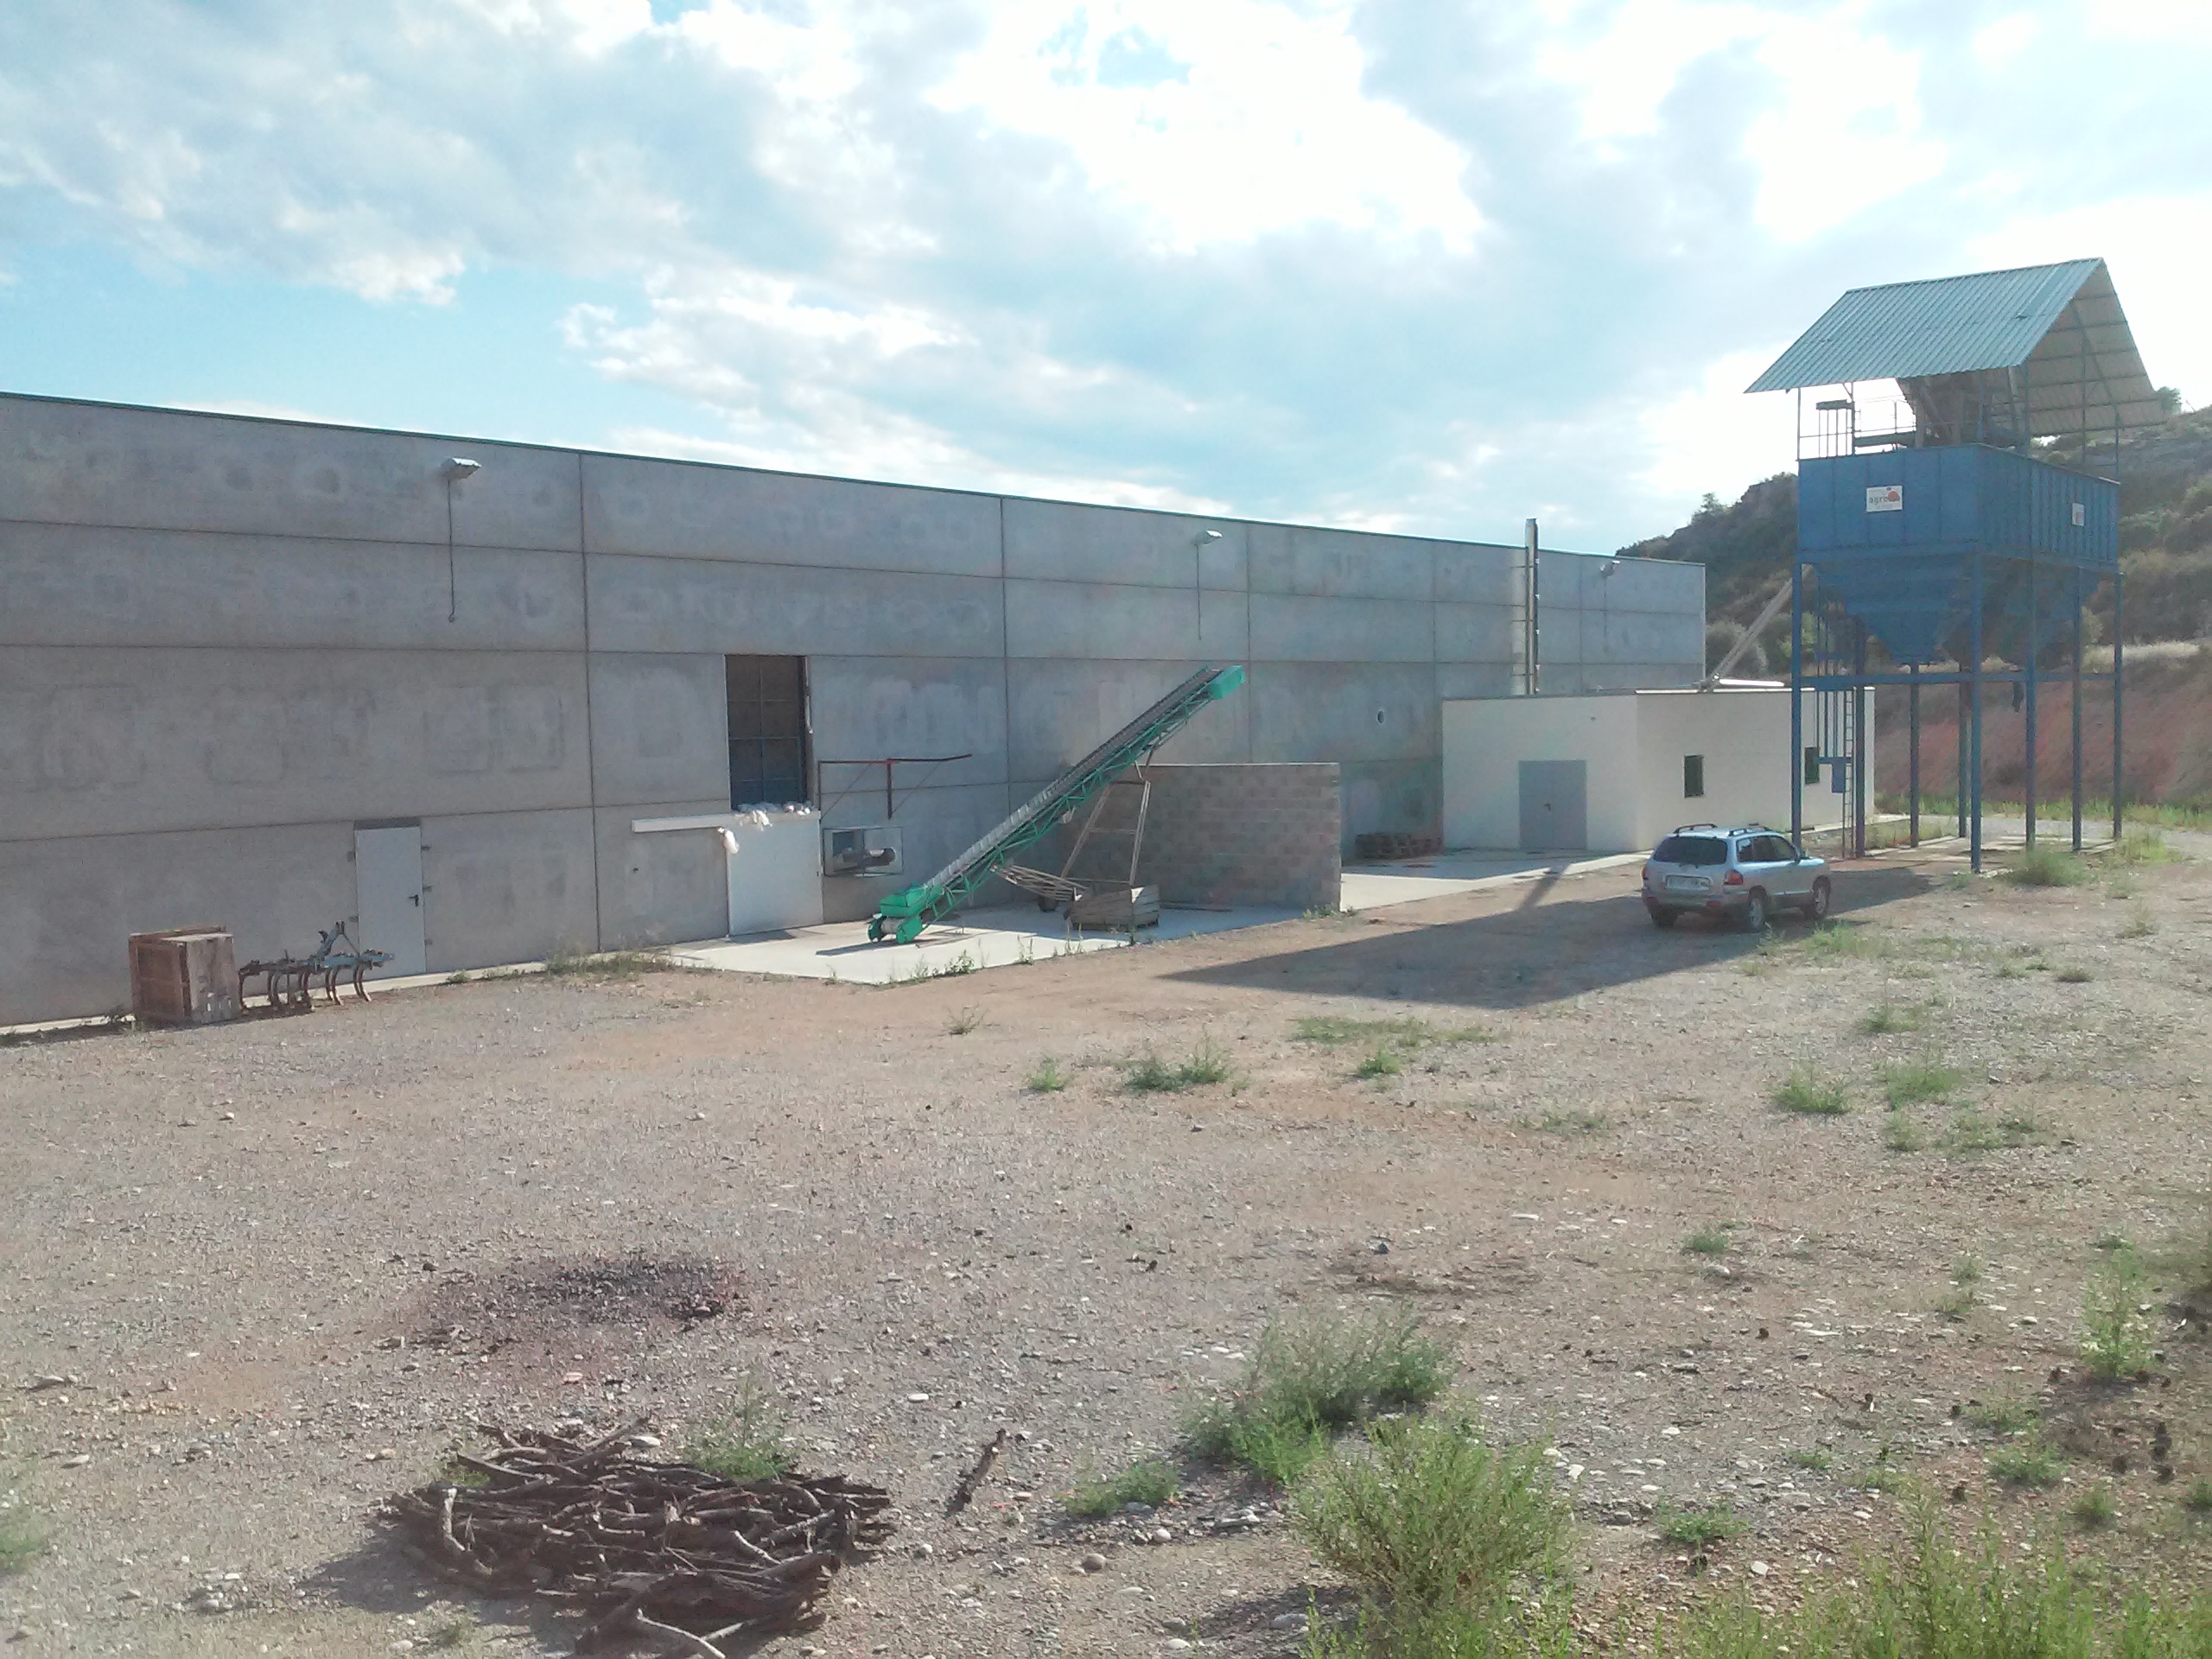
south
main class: Shrubland
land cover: Shrubland with sparse tree cover
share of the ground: > 75 %
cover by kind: shrubs 55 %, herbaceous plants 30 %, consolidated bare surface 10 %, broadleaved forest trees 5 %
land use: Semi-natural and natural areas not in use
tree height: < 5 m
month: August
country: ES
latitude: 41.3778
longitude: 0.7713
